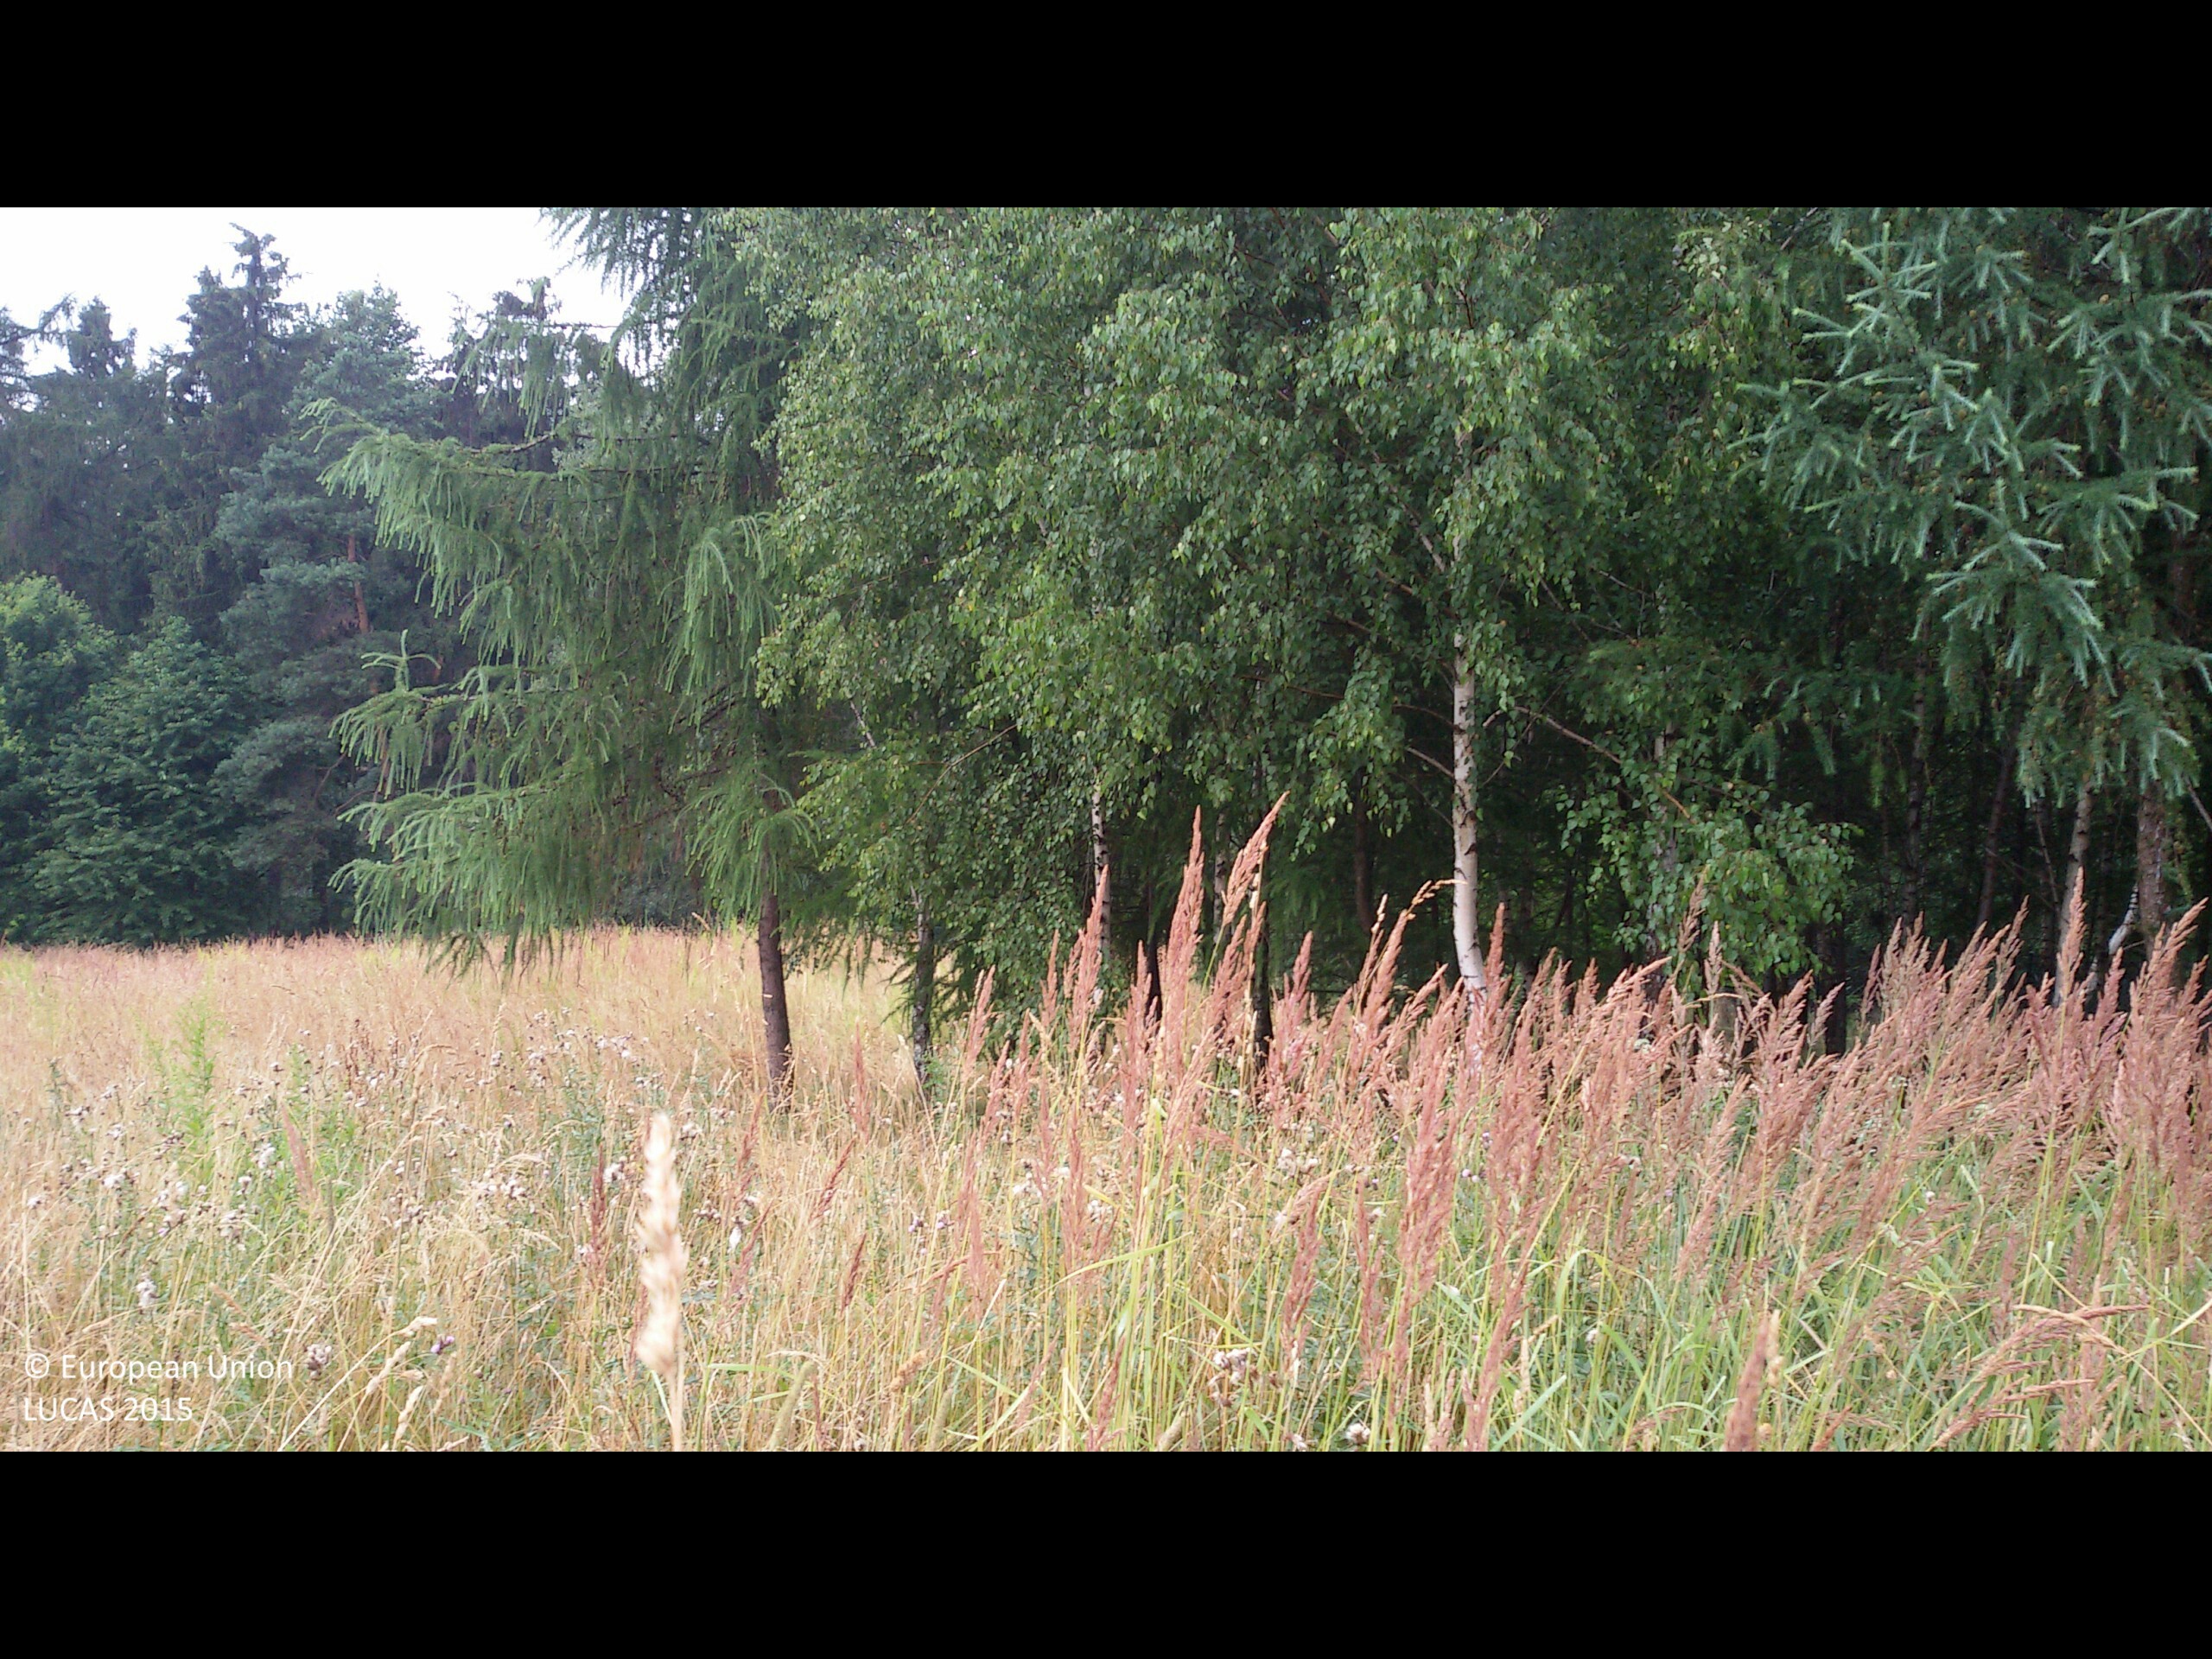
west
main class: Grassland
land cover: Grassland without tree/shrub cover
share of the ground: > 75 %
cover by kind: herbaceous plants 100 %
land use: Agriculture (excluding fallow land and kitchen gardens)
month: July
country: PL
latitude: 50.0056
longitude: 18.5725
